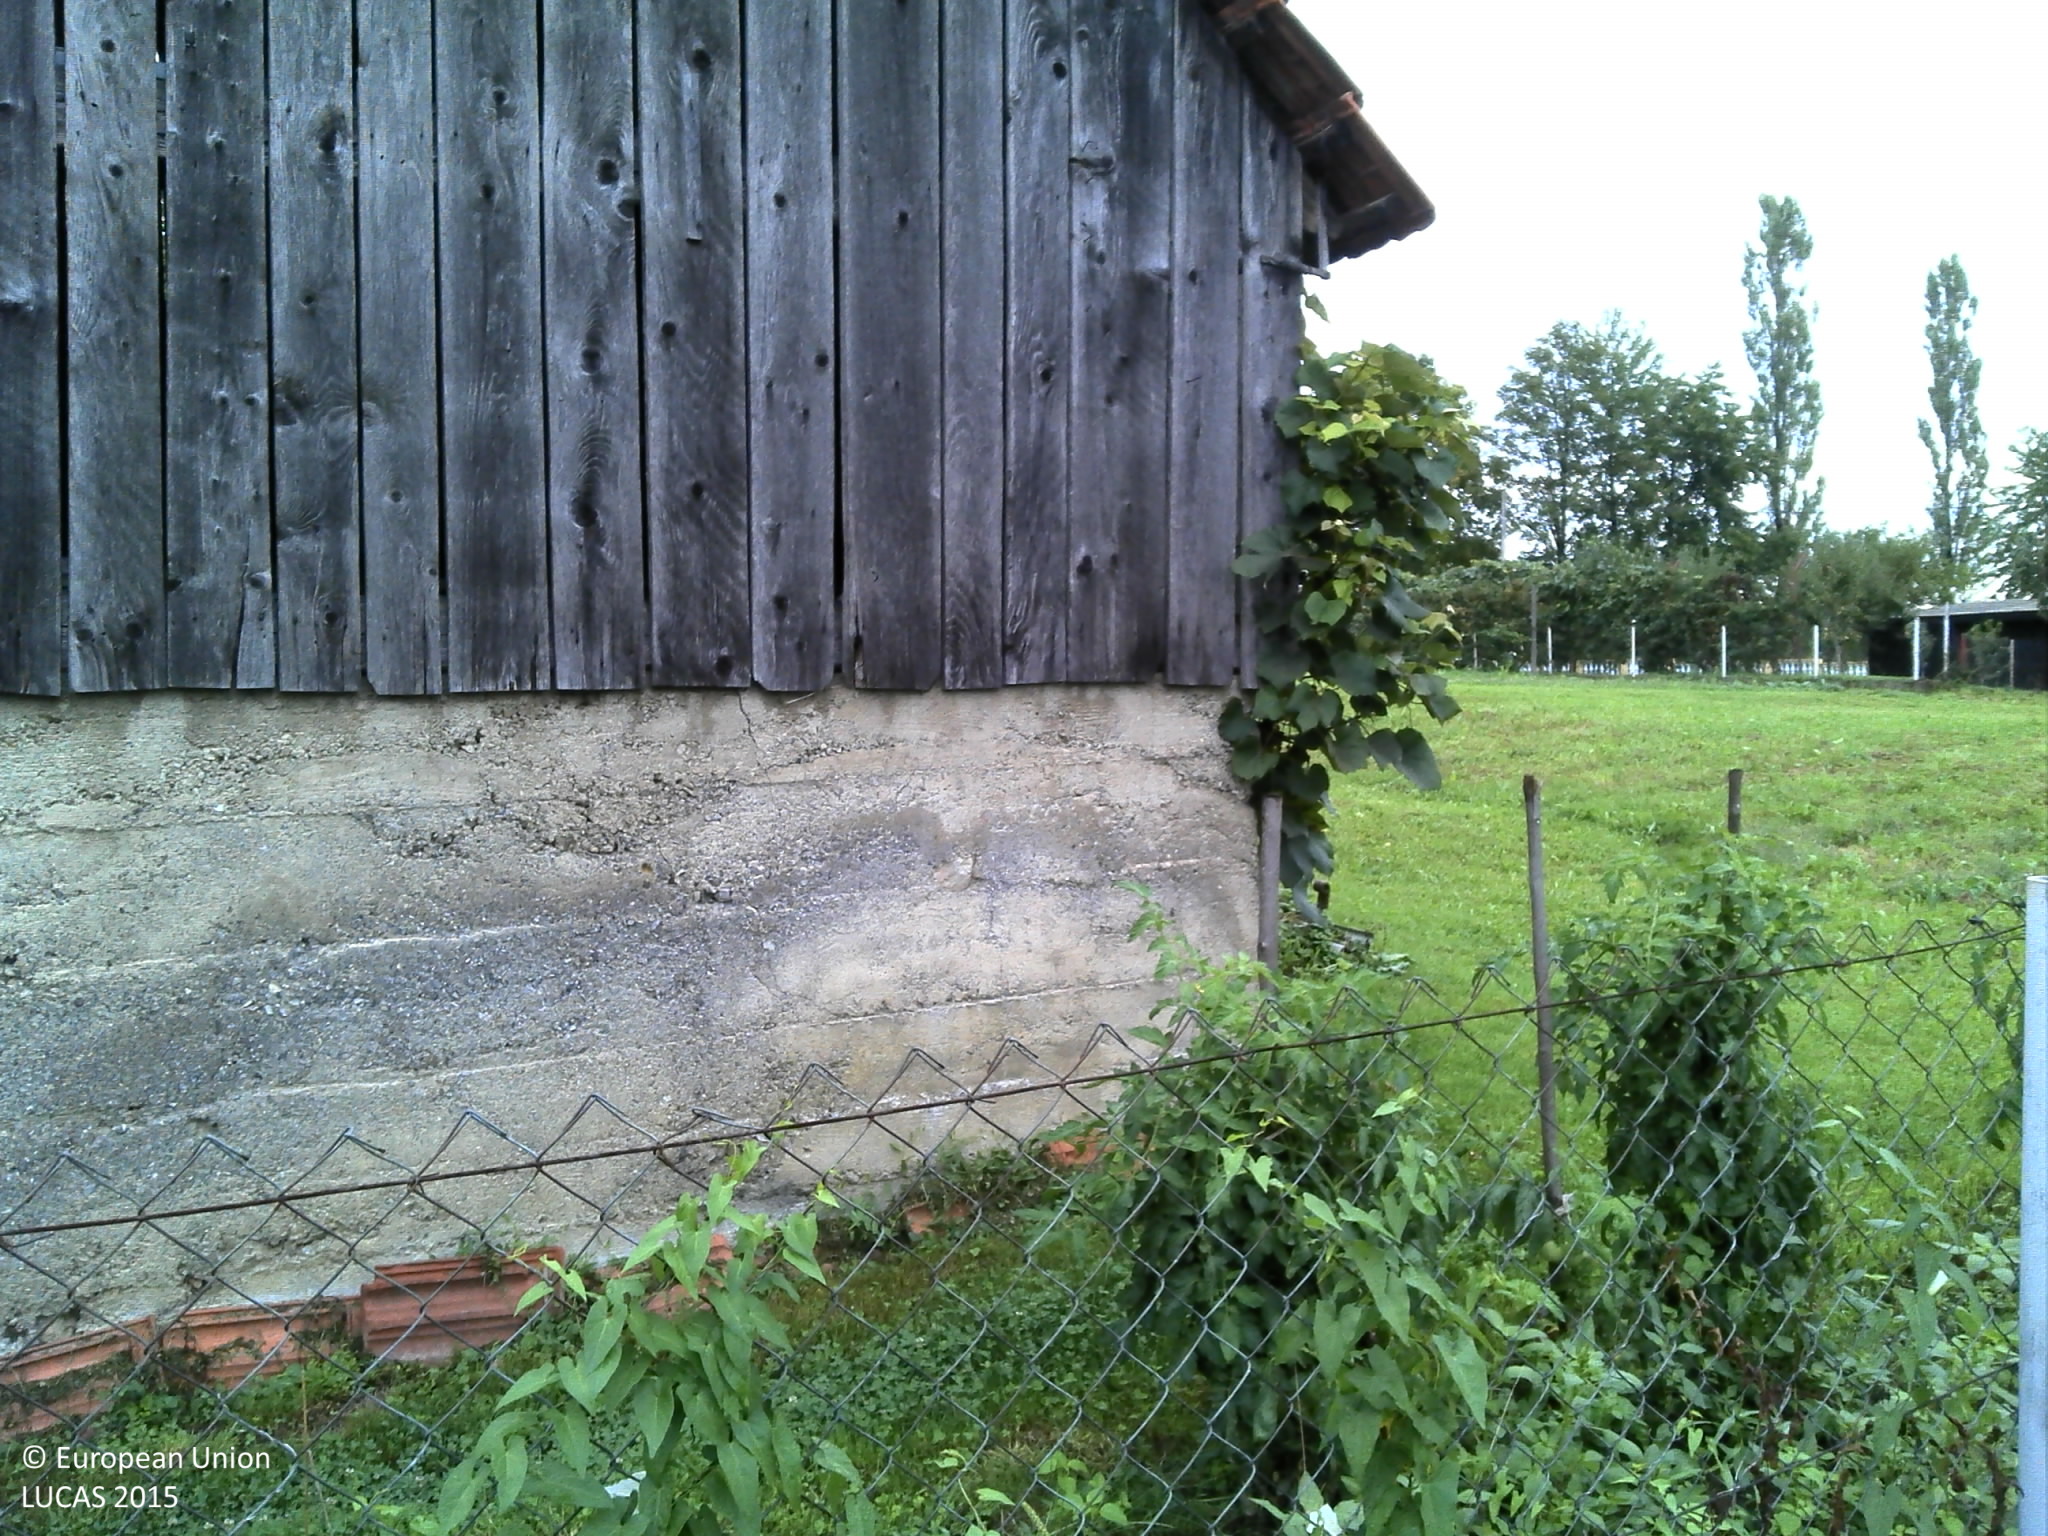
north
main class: Grassland
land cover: Grassland without tree/shrub cover
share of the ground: > 75 %
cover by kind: herbaceous plants 100 %
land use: Residential
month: September
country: HR
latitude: 45.2483
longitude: 15.2318
